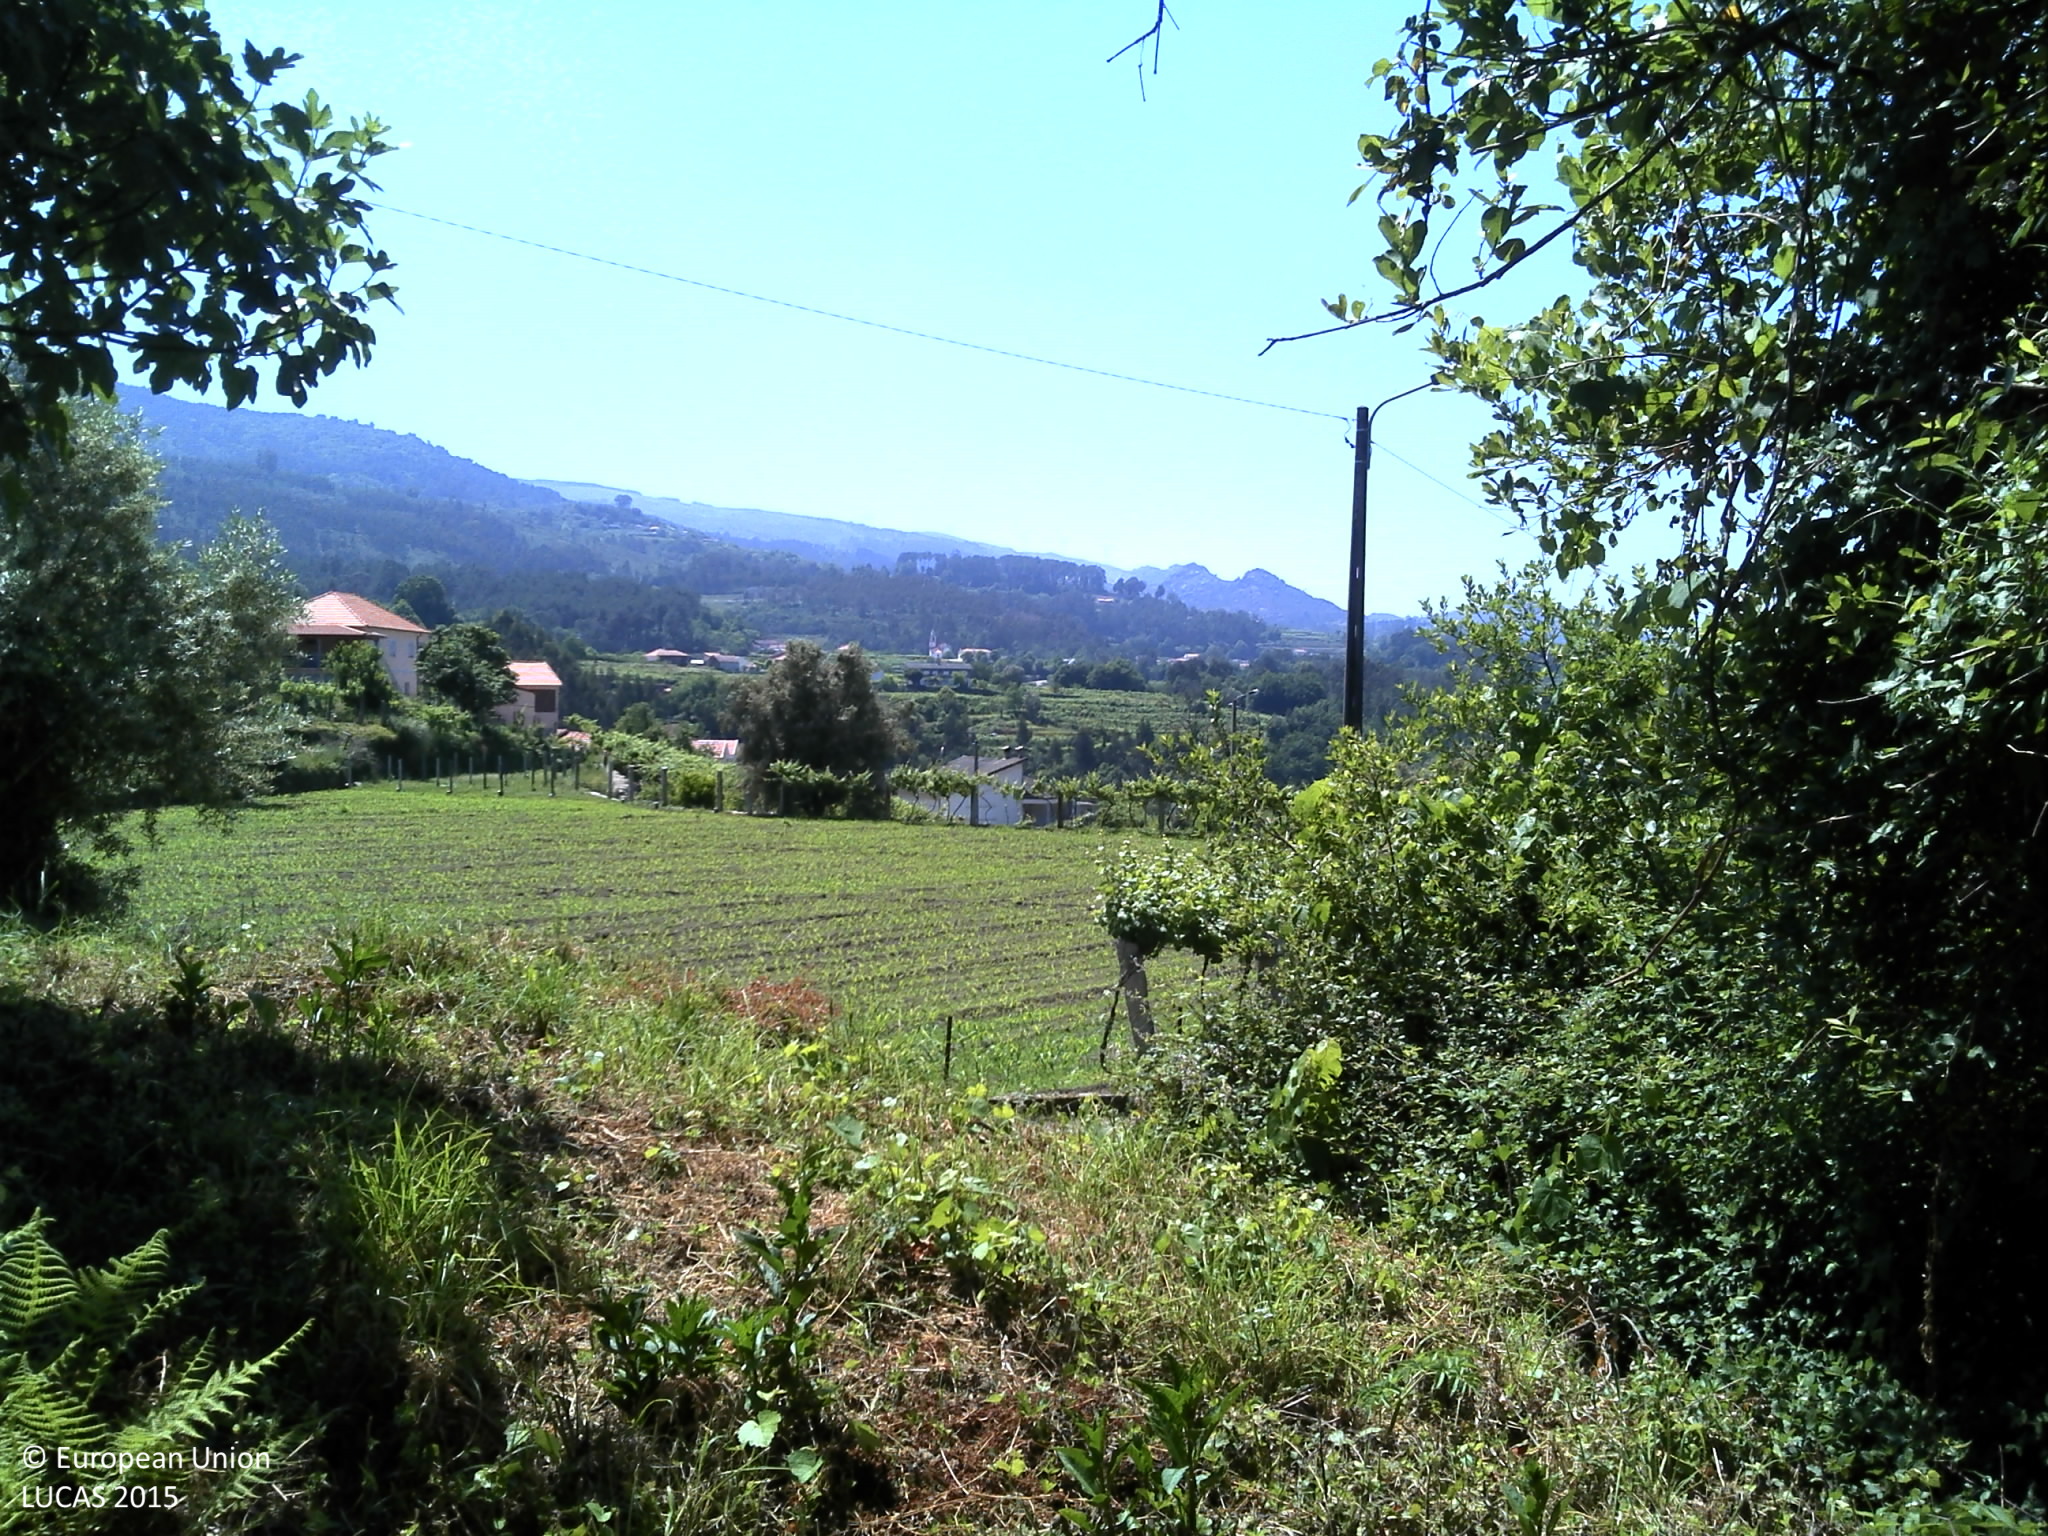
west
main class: Shrubland
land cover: Shrubland without tree cover
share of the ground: 50 - 75 %
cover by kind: shrubs 50 %, herbaceous plants 40 %, consolidated bare surface 10 %
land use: Abandoned areas
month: June
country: PT
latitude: 41.9903
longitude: -8.4741
